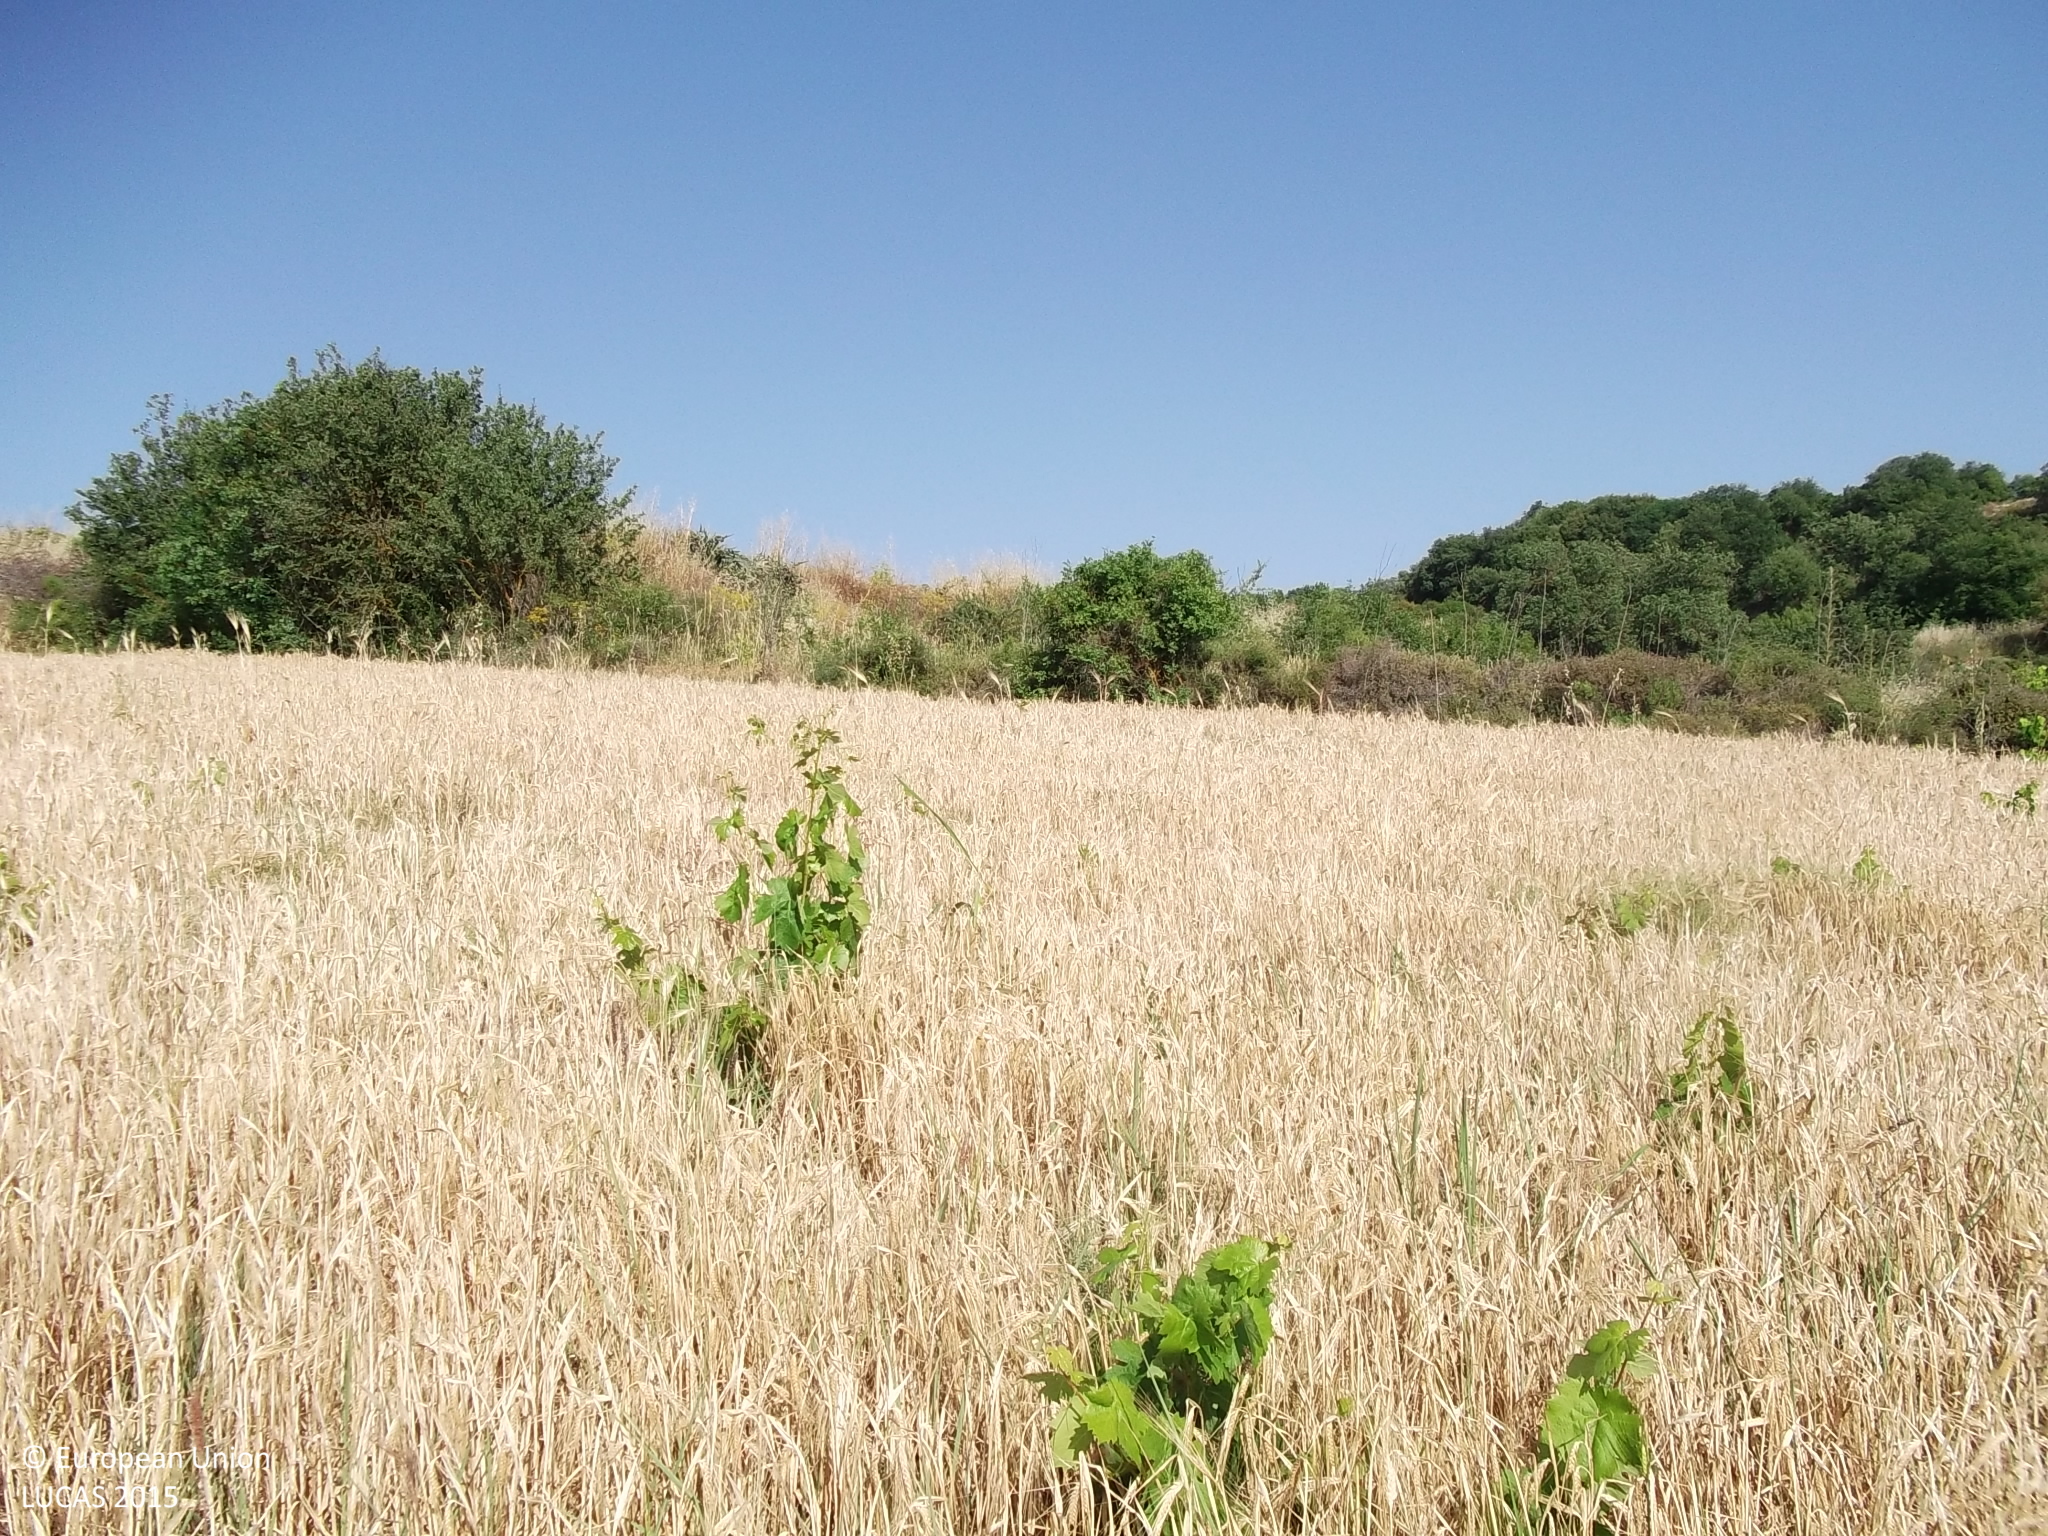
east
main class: Cropland
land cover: Barley
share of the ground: > 75 %
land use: Agriculture (excluding fallow land and kitchen gardens)
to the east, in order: Barley; Grassland with sparse tree/shrub cover; Mixed cereals for fodder; Shrubland without tree cover; Mixed cereals for fodder; Paved roads, cycling and walking lanes; Shrubland with sparse tree cover; Vineyards; Shrubland without tree cover; Vineyards; Shrubland without tree cover; Other bare soil
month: May
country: CY
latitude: 34.8488
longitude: 32.5614
